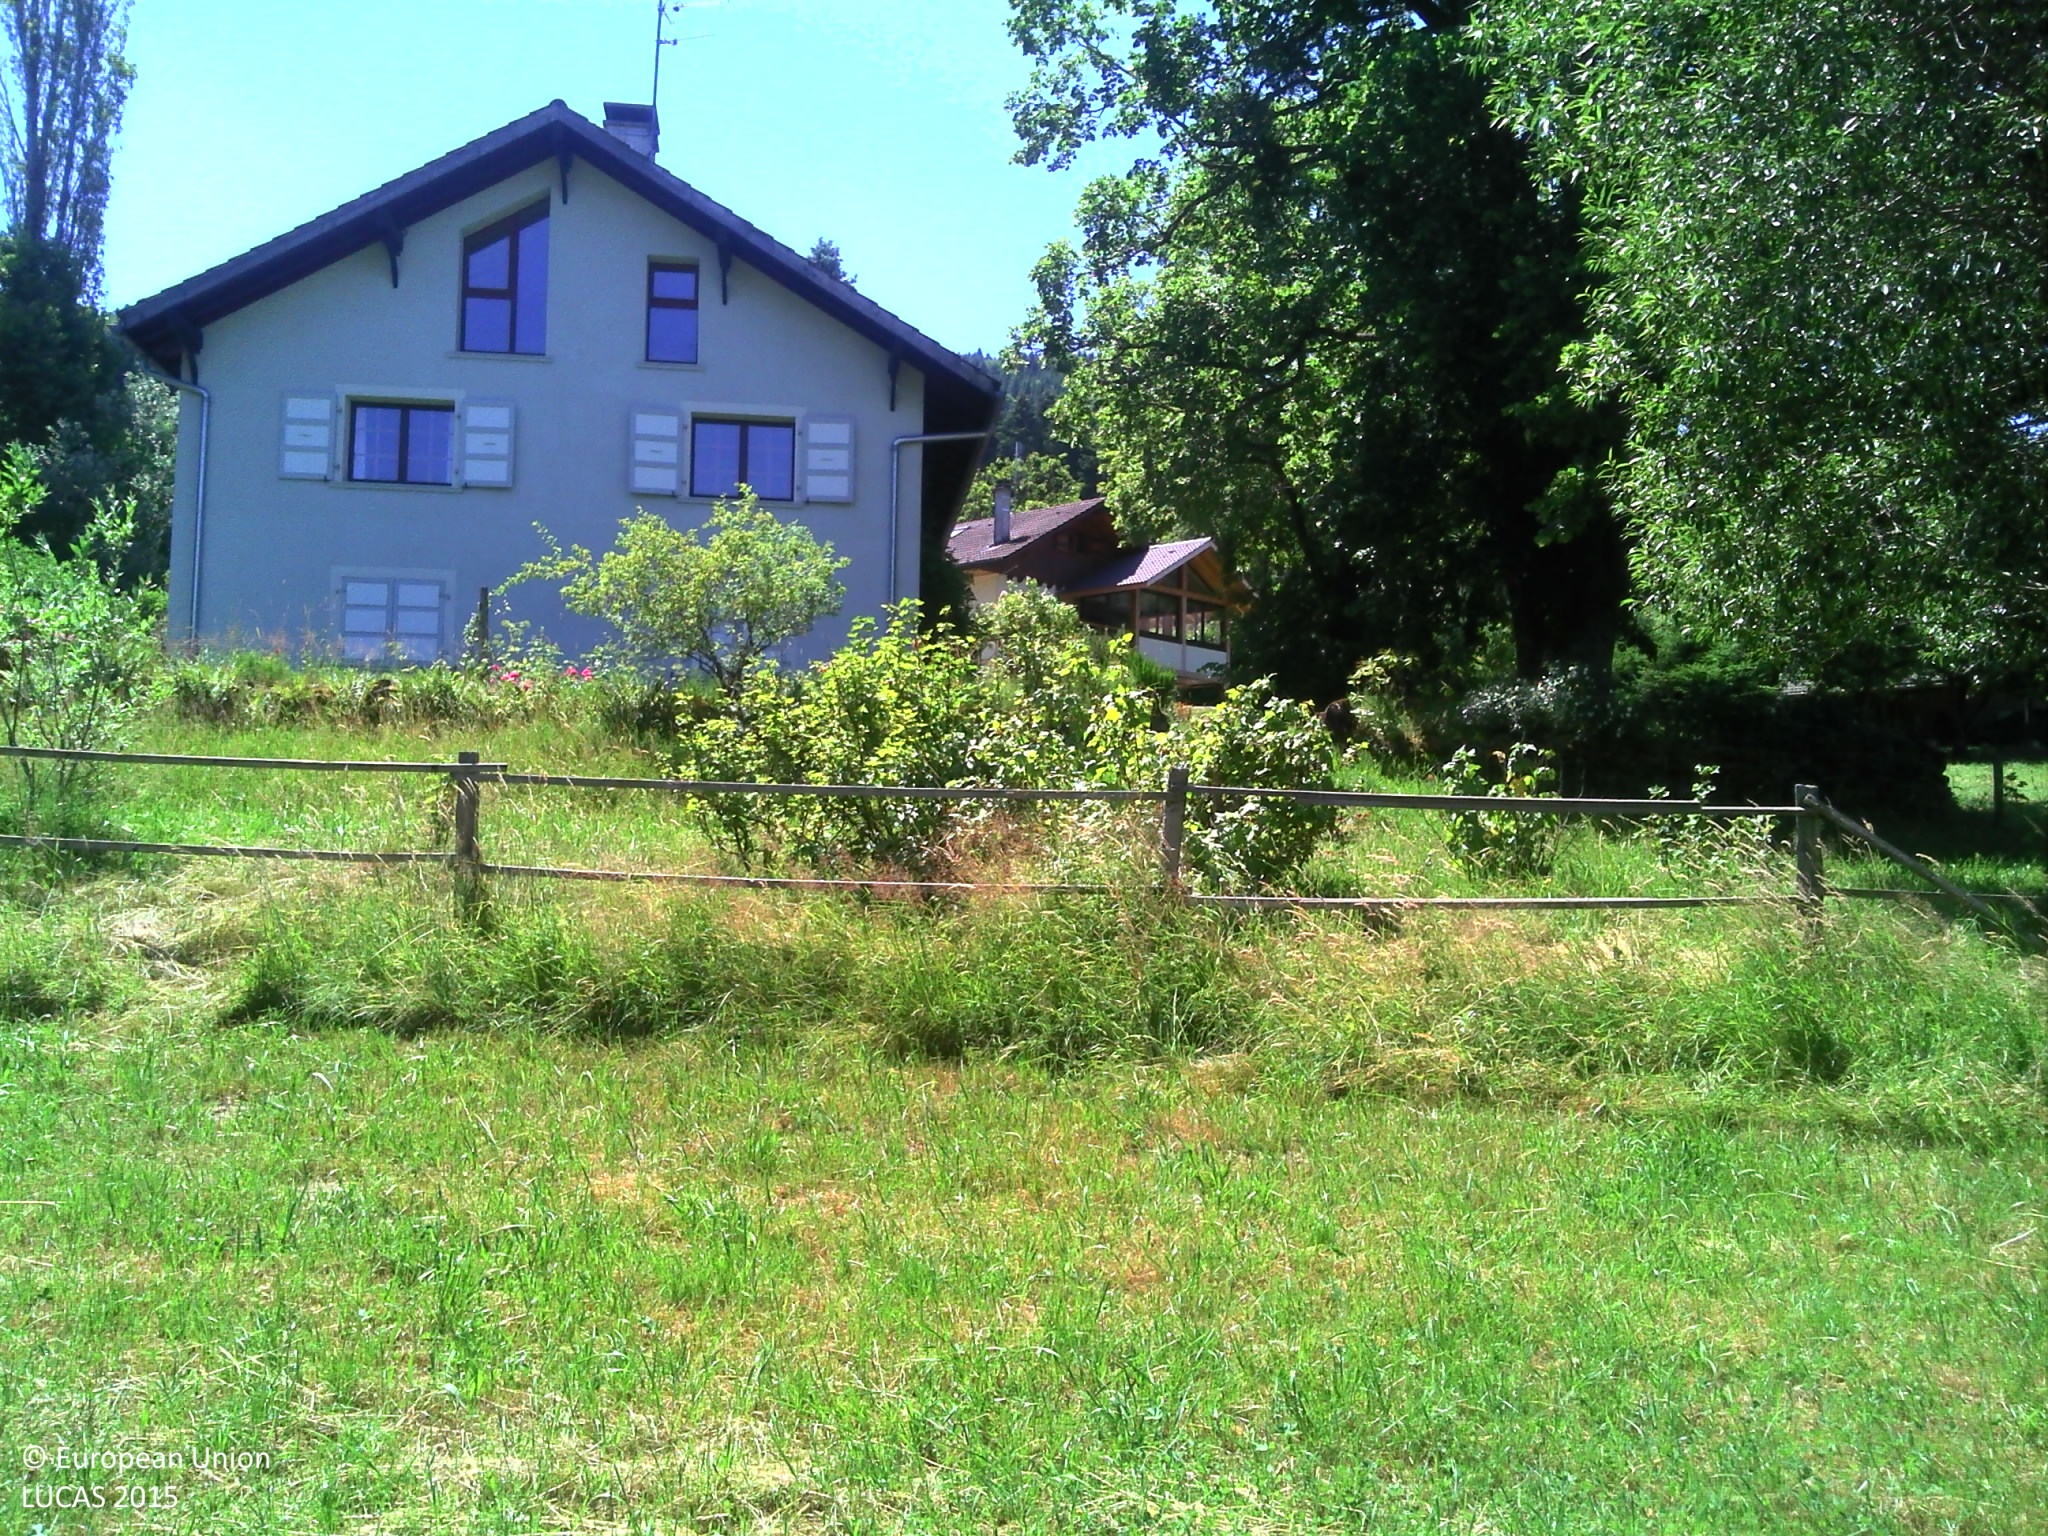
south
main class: Grassland
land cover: Grassland without tree/shrub cover
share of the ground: > 75 %
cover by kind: herbaceous plants 100 %
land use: Agriculture (excluding fallow land and kitchen gardens)
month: July
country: FR
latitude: 46.2549
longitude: 6.4101
